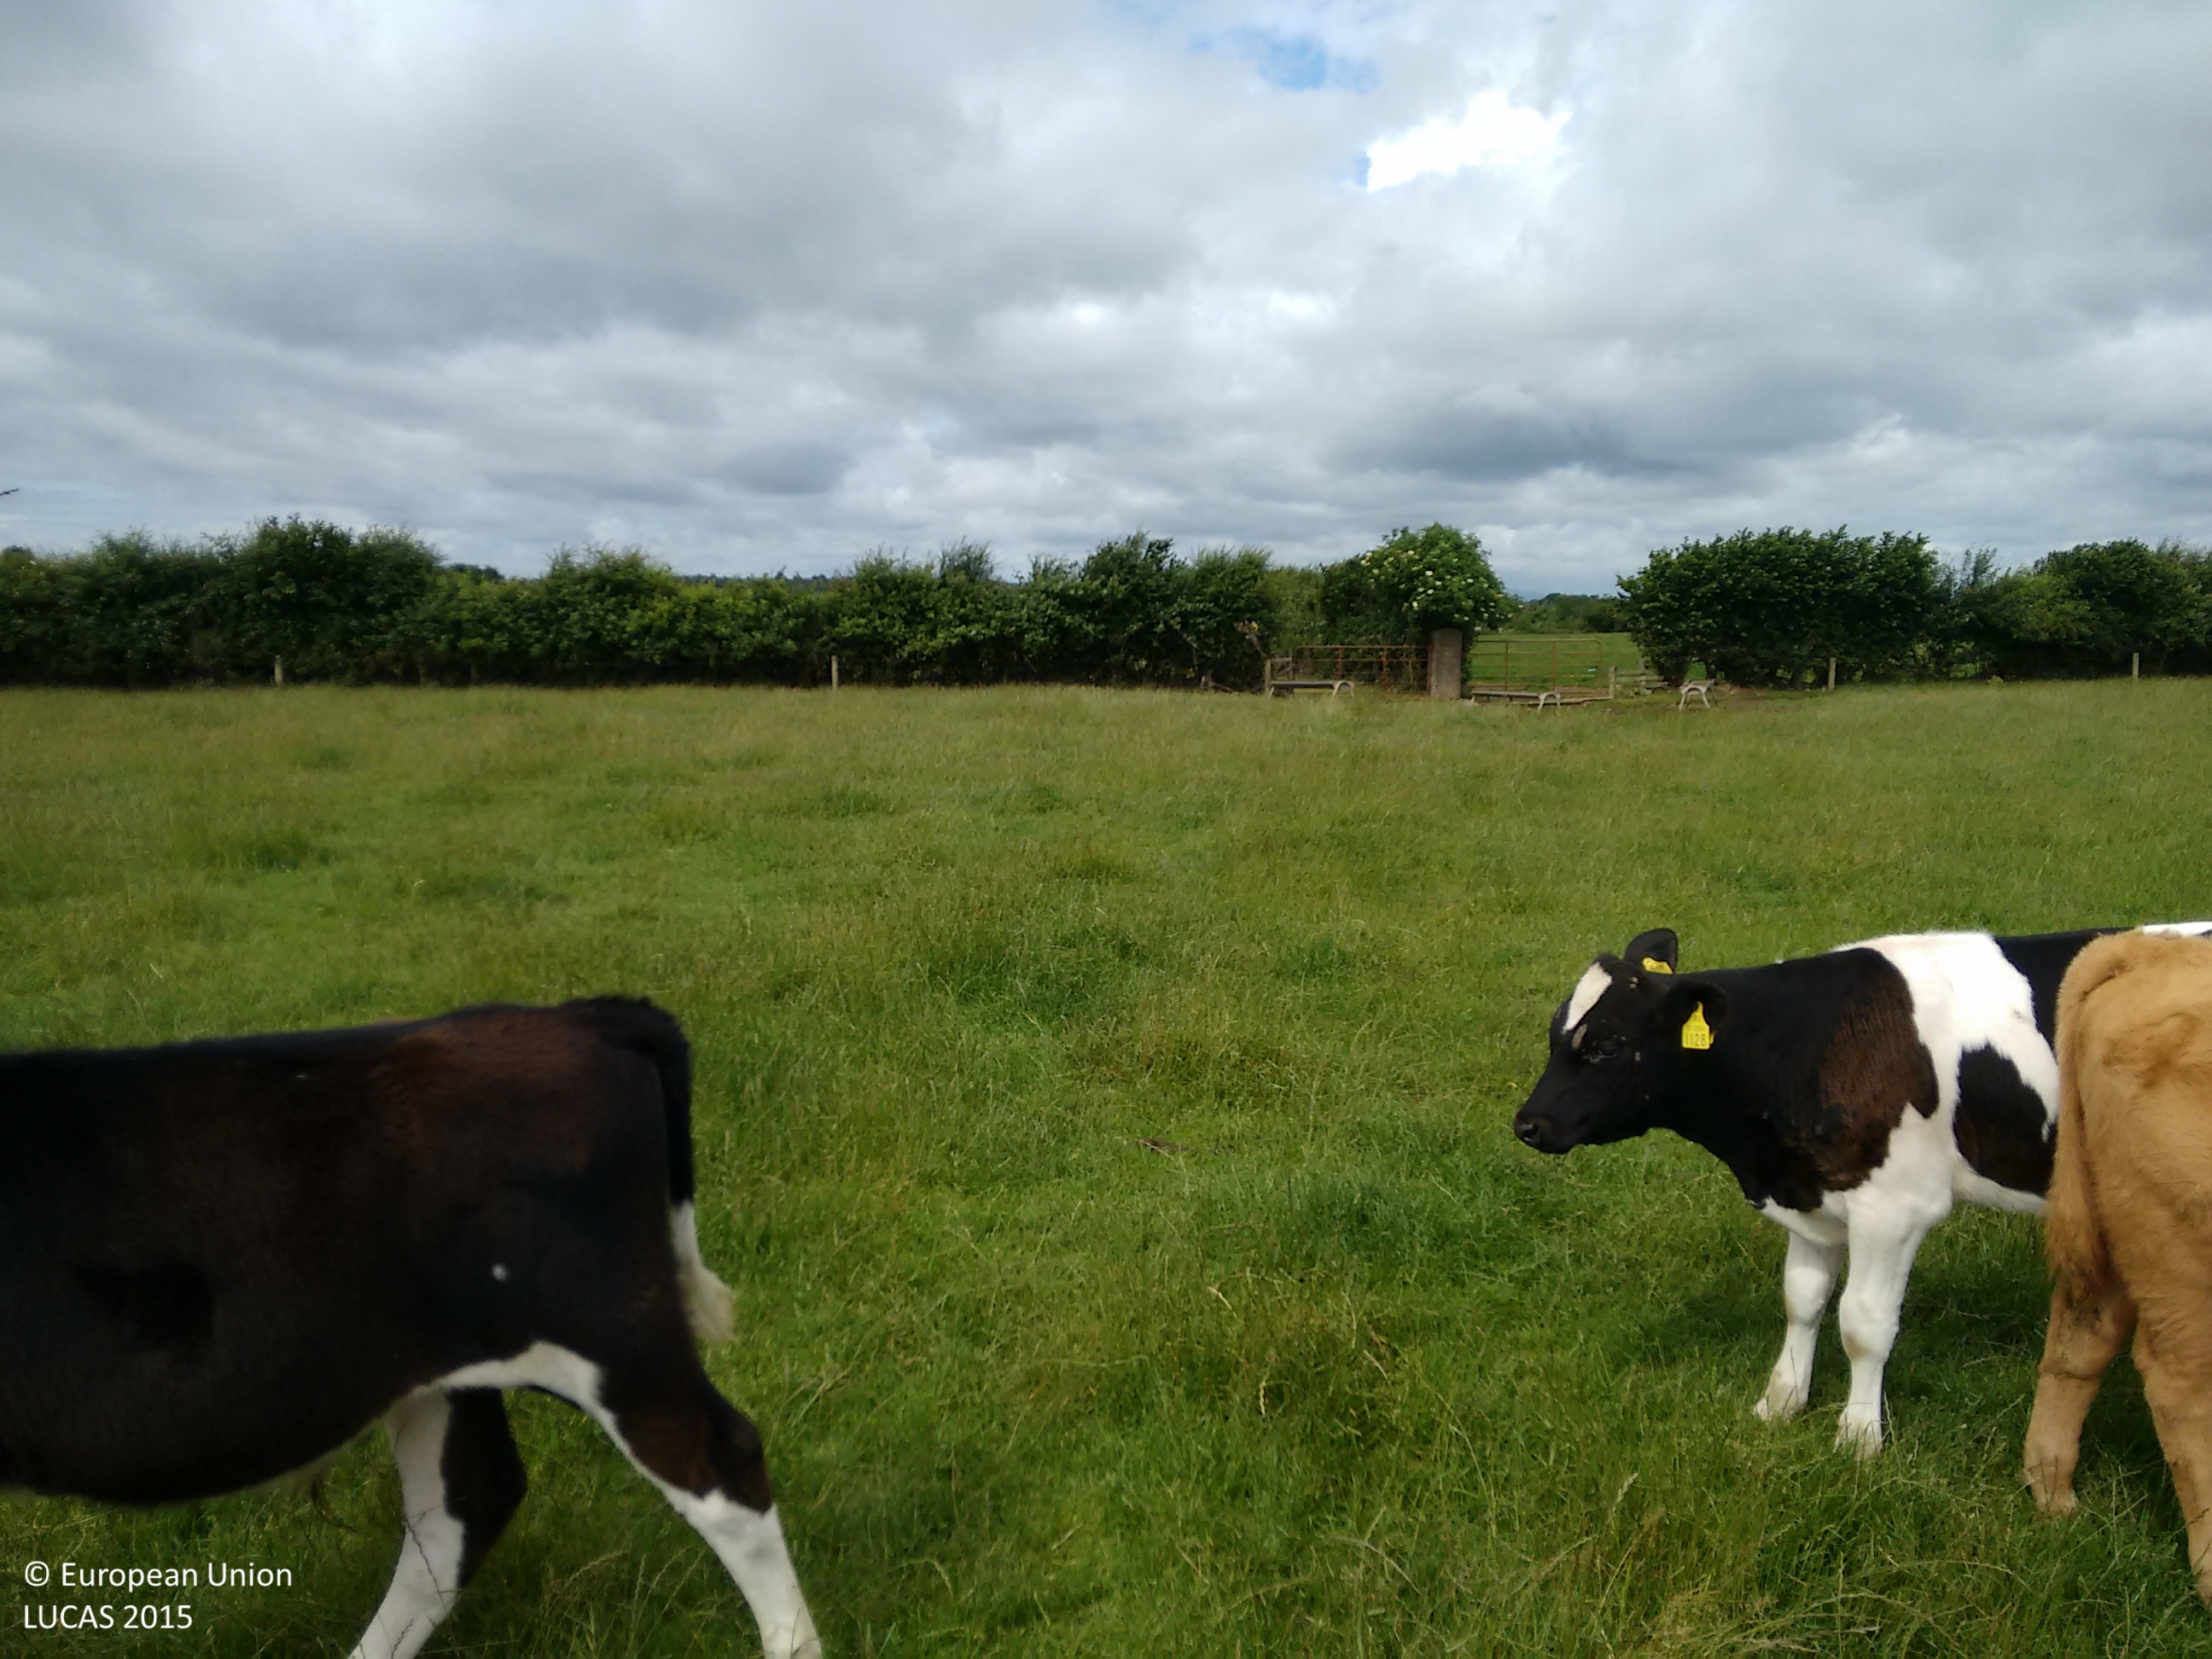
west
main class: Grassland
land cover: Grassland without tree/shrub cover
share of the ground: > 75 %
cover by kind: herbaceous plants 100 %
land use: Agriculture (excluding fallow land and kitchen gardens)
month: July
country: IE
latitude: 52.8038
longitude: -7.5604
